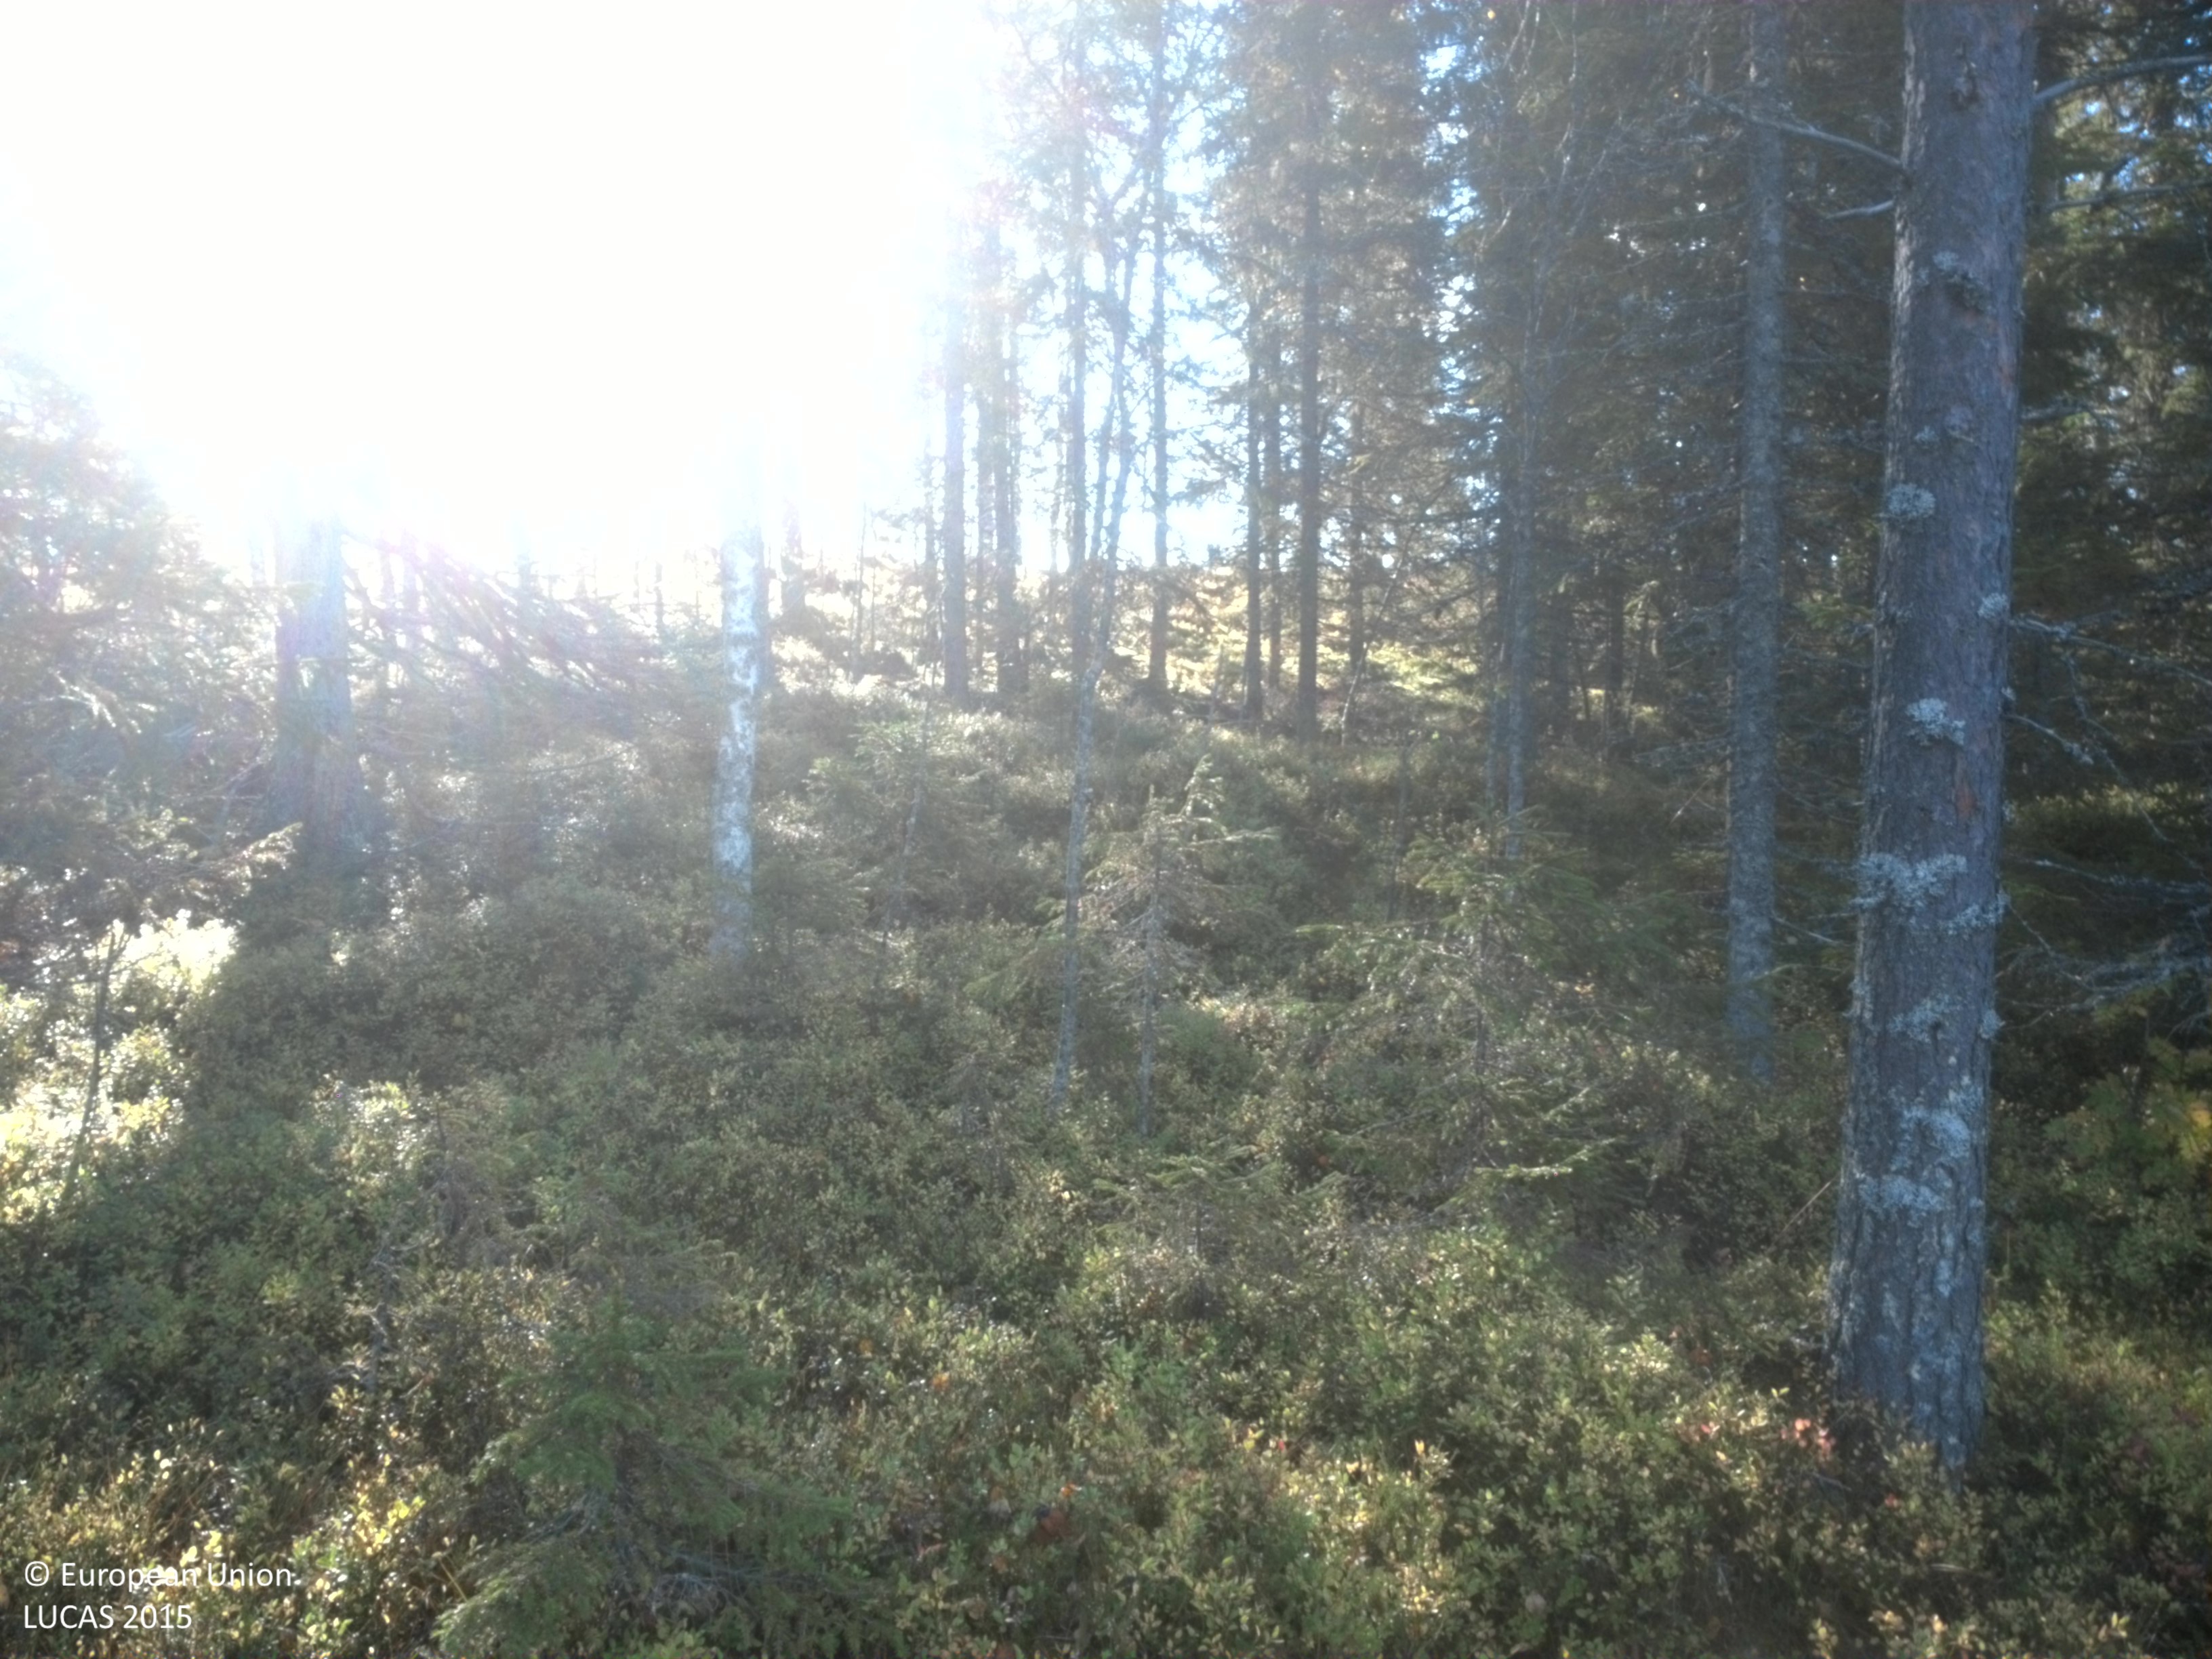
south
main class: Woodland
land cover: Pine dominated coniferous woodland
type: boreal forest
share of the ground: 10 - 25 %
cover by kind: shrubs 40 %, herbaceous plants 35 %, lichens and mosses 15 %, coniferous forest trees 10 %
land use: Semi-natural and natural areas not in use
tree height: > 5 m
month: September
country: SE
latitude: 64.2675
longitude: 19.9467
